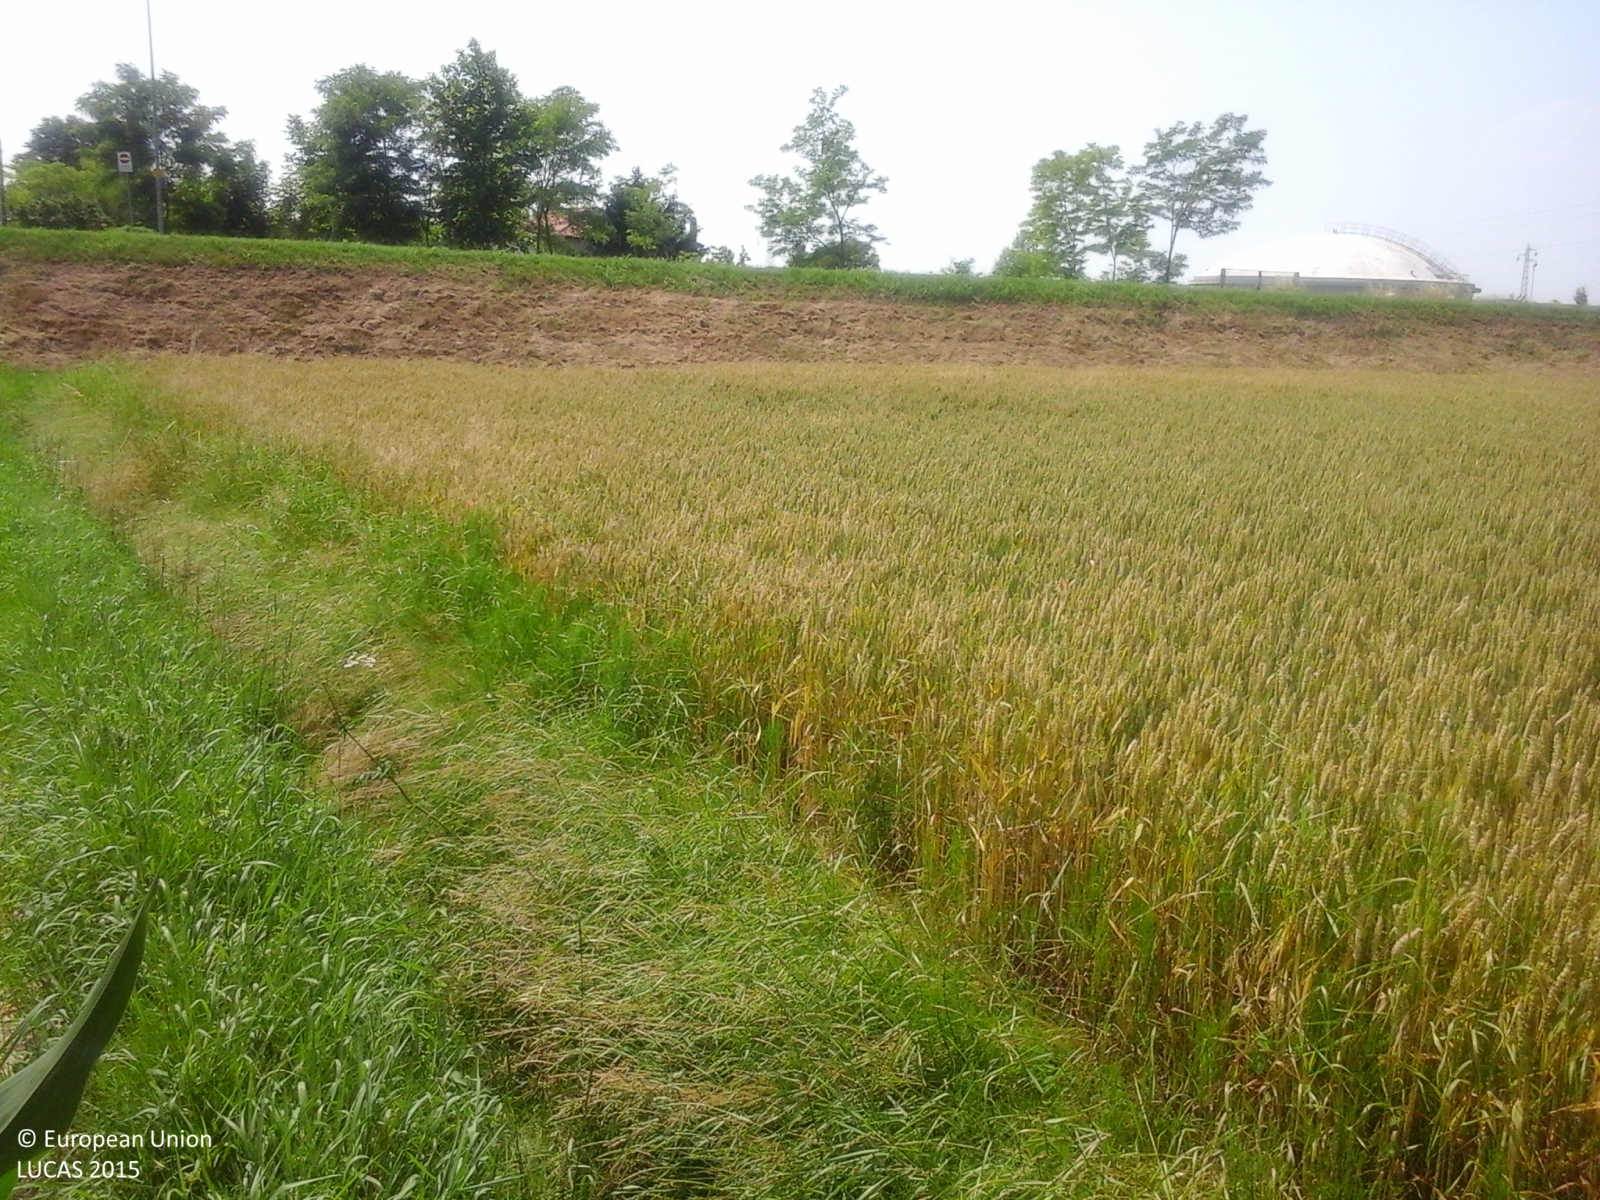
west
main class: Cropland
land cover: Common wheat
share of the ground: > 75 %
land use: Agriculture (excluding fallow land and kitchen gardens)
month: June
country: IT
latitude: 45.6365
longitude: 12.5236
